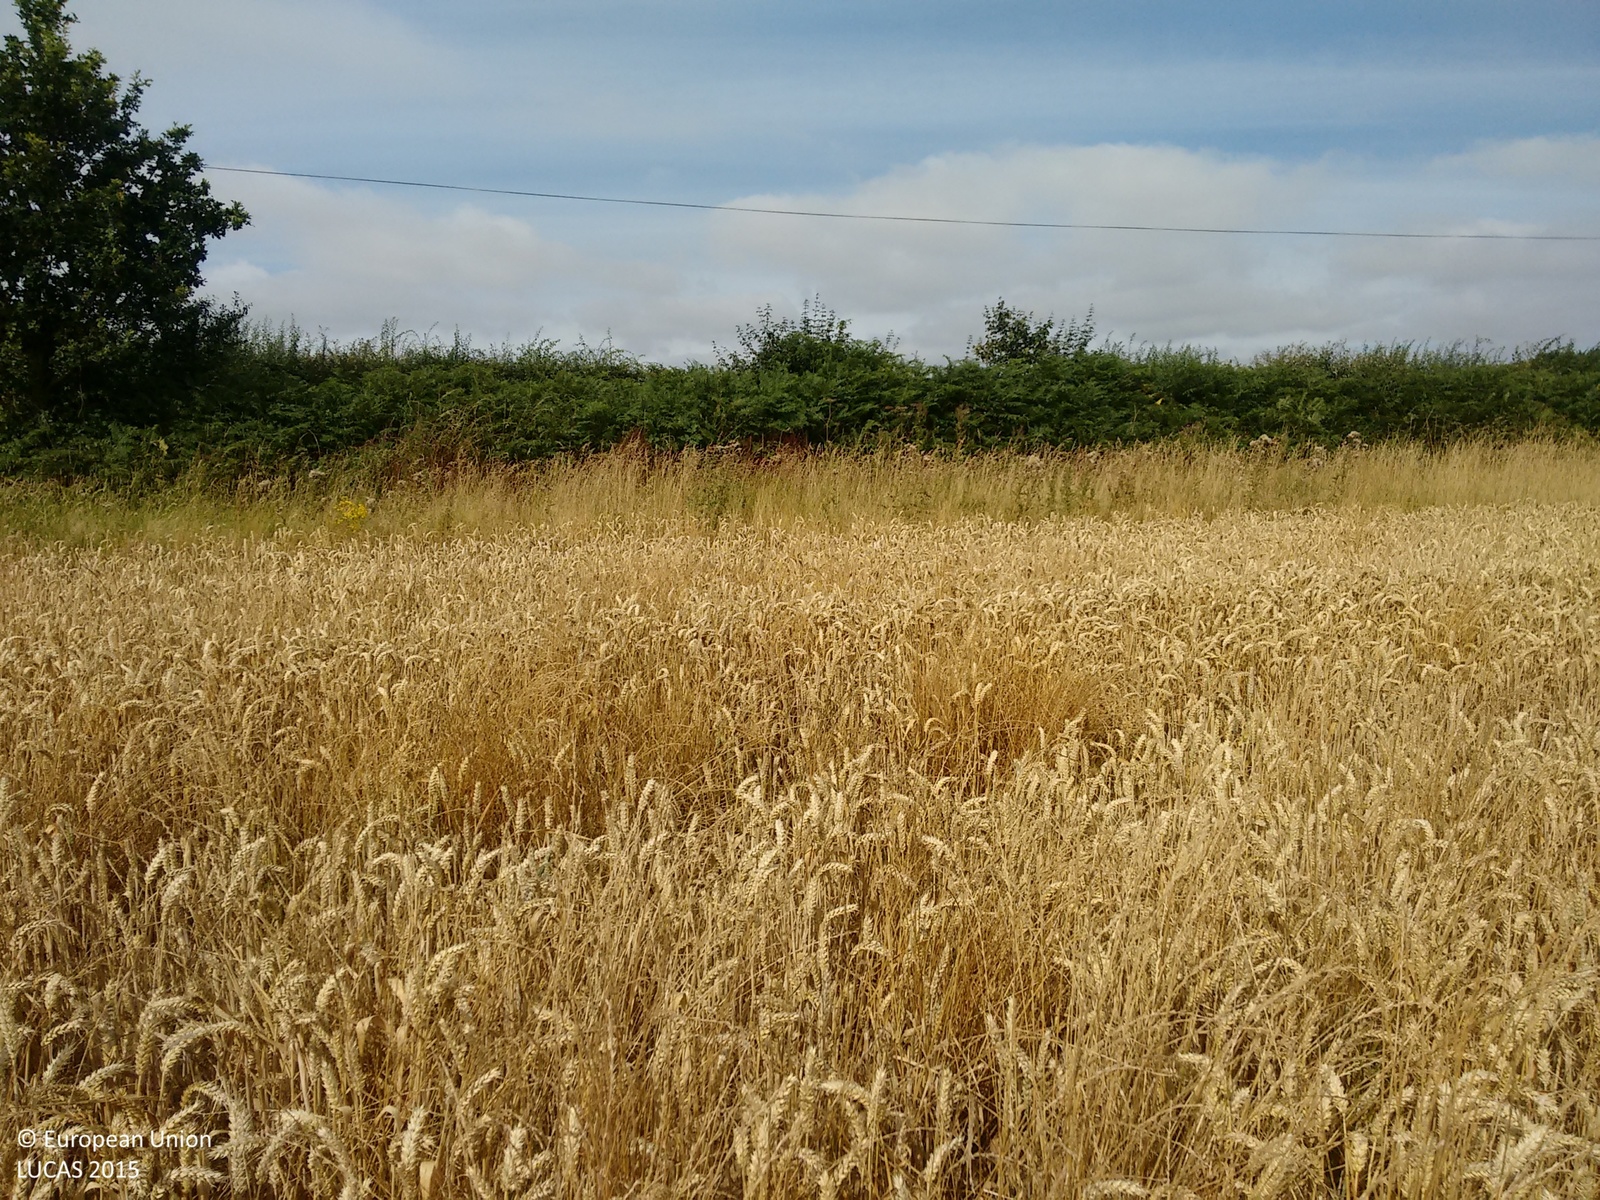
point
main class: Cropland
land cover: Common wheat
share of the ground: > 75 %
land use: Agriculture (excluding fallow land and kitchen gardens)
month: August
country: GB
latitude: 51.8400
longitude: 1.0510
